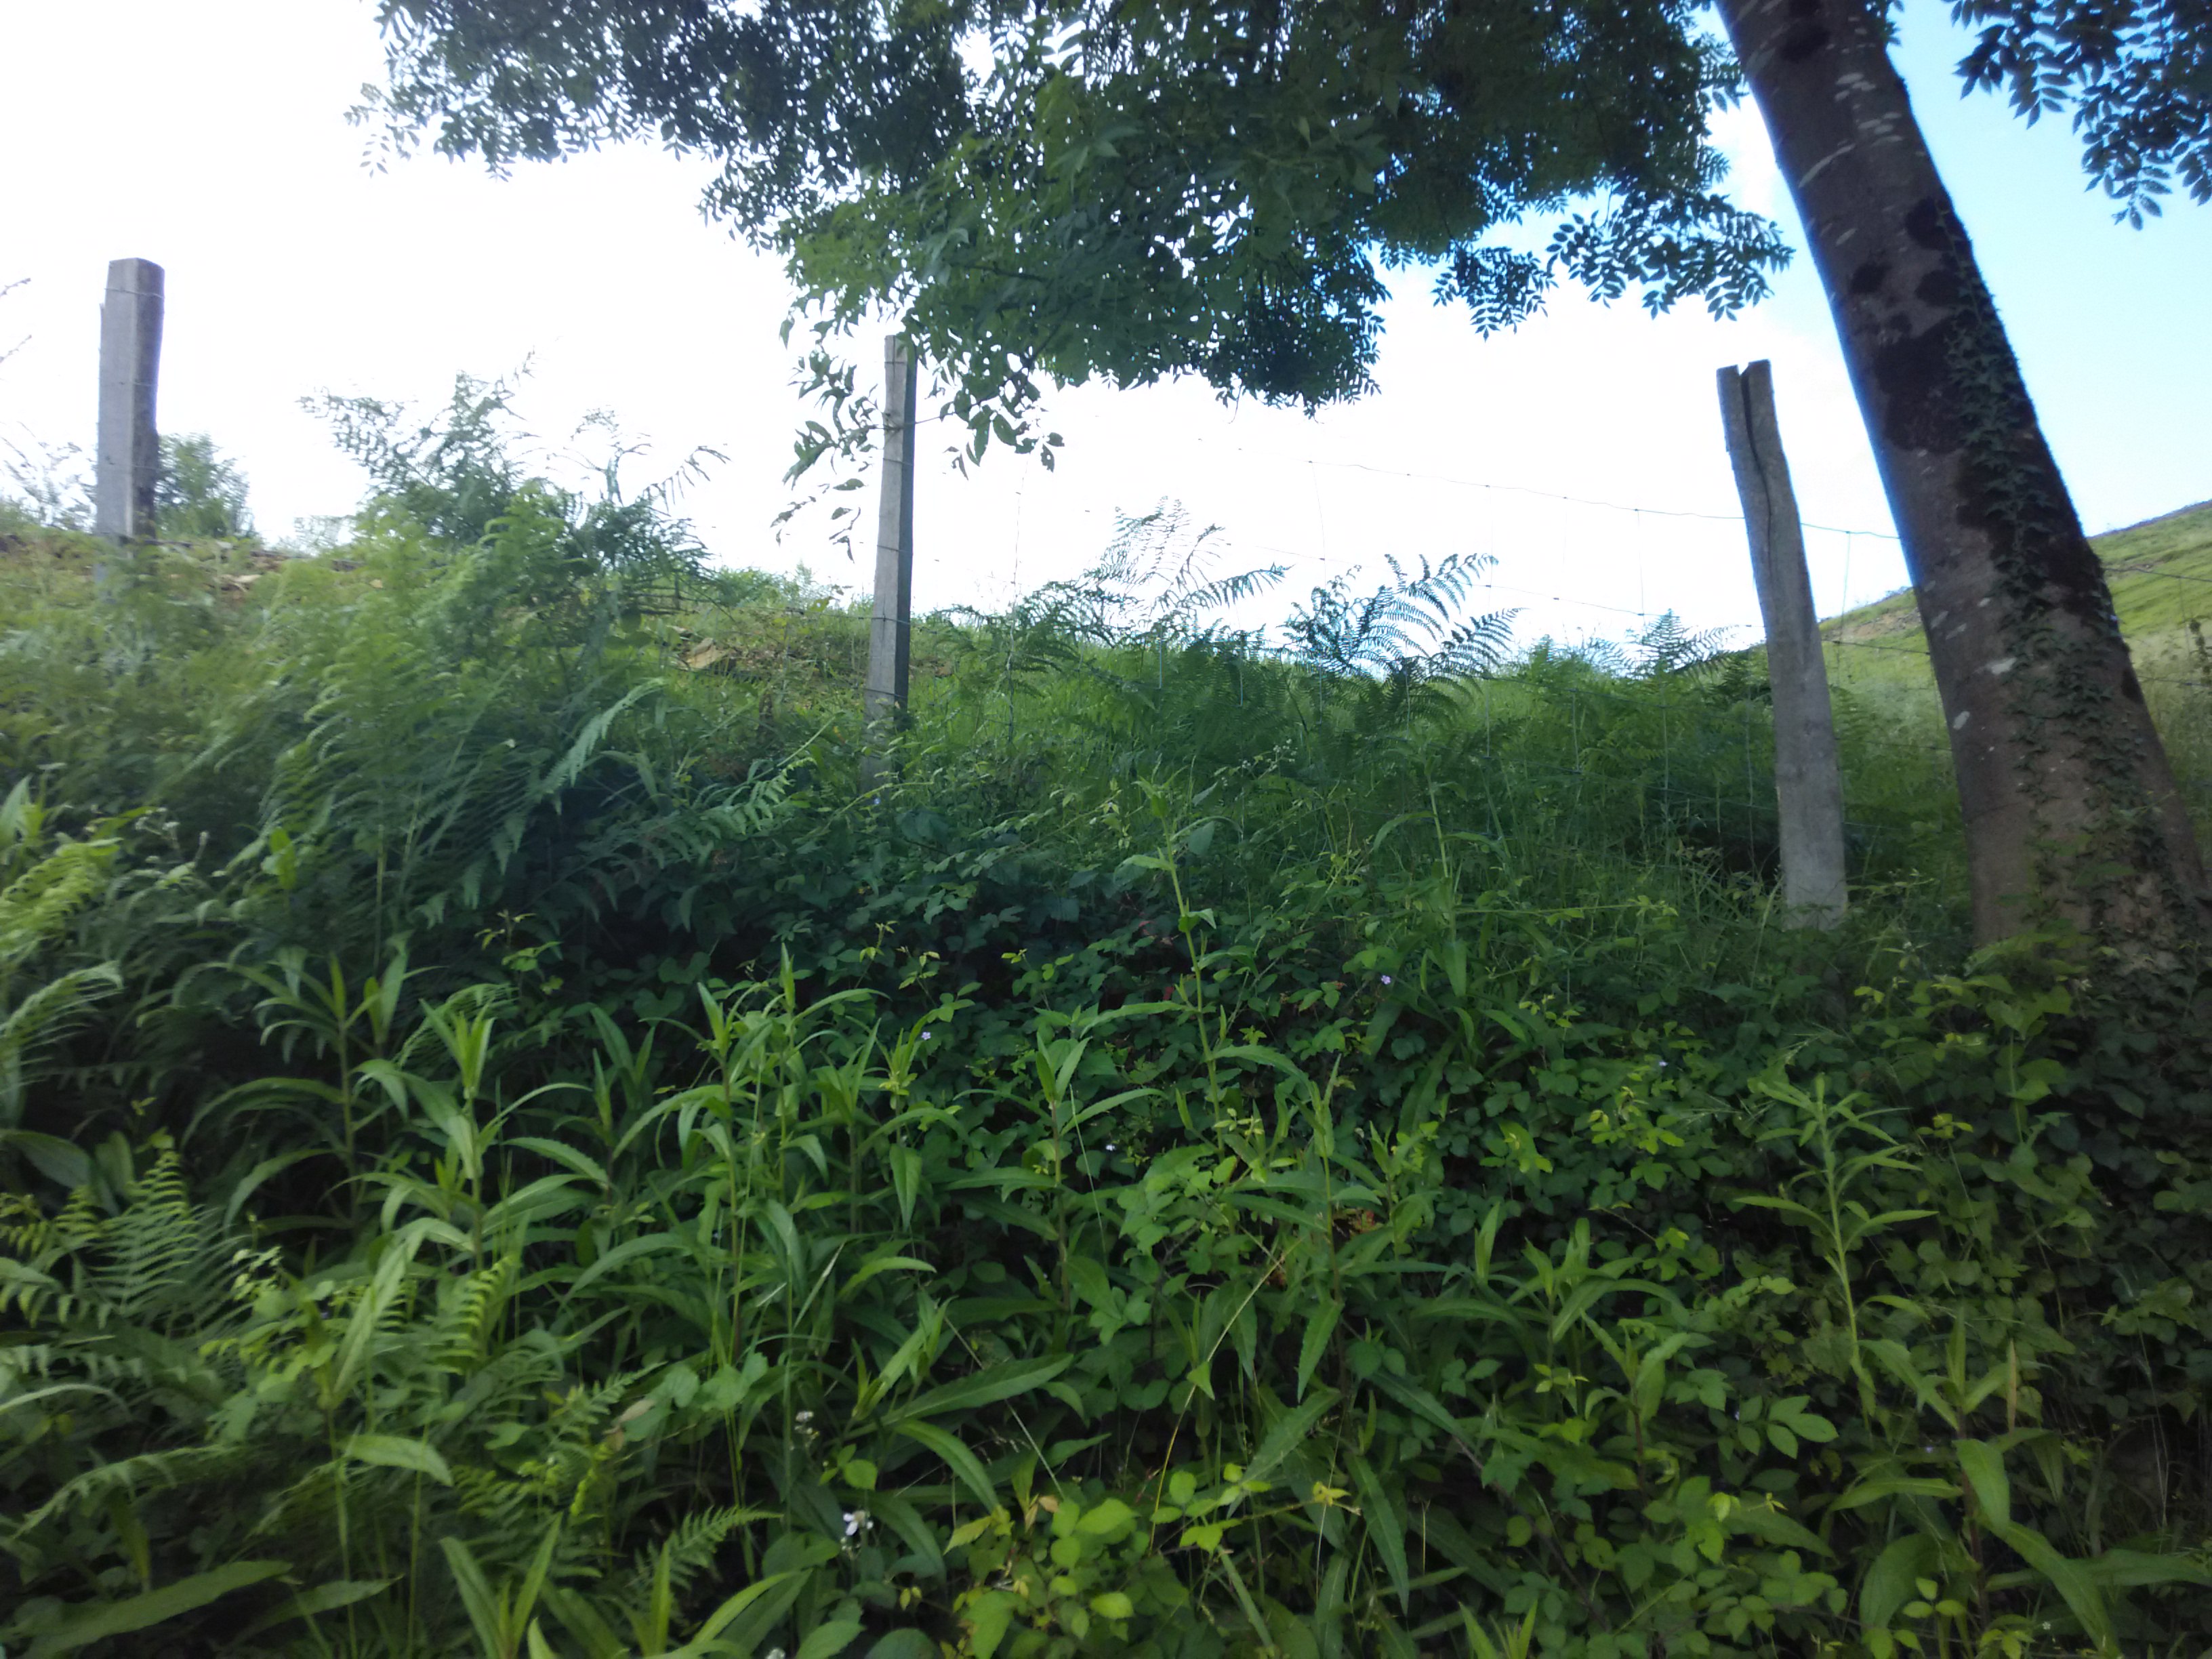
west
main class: Grassland
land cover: Grassland without tree/shrub cover
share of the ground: > 75 %
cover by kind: herbaceous plants 100 %
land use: Agriculture (excluding fallow land and kitchen gardens)
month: June
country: ES
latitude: 43.2208
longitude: -2.2496
